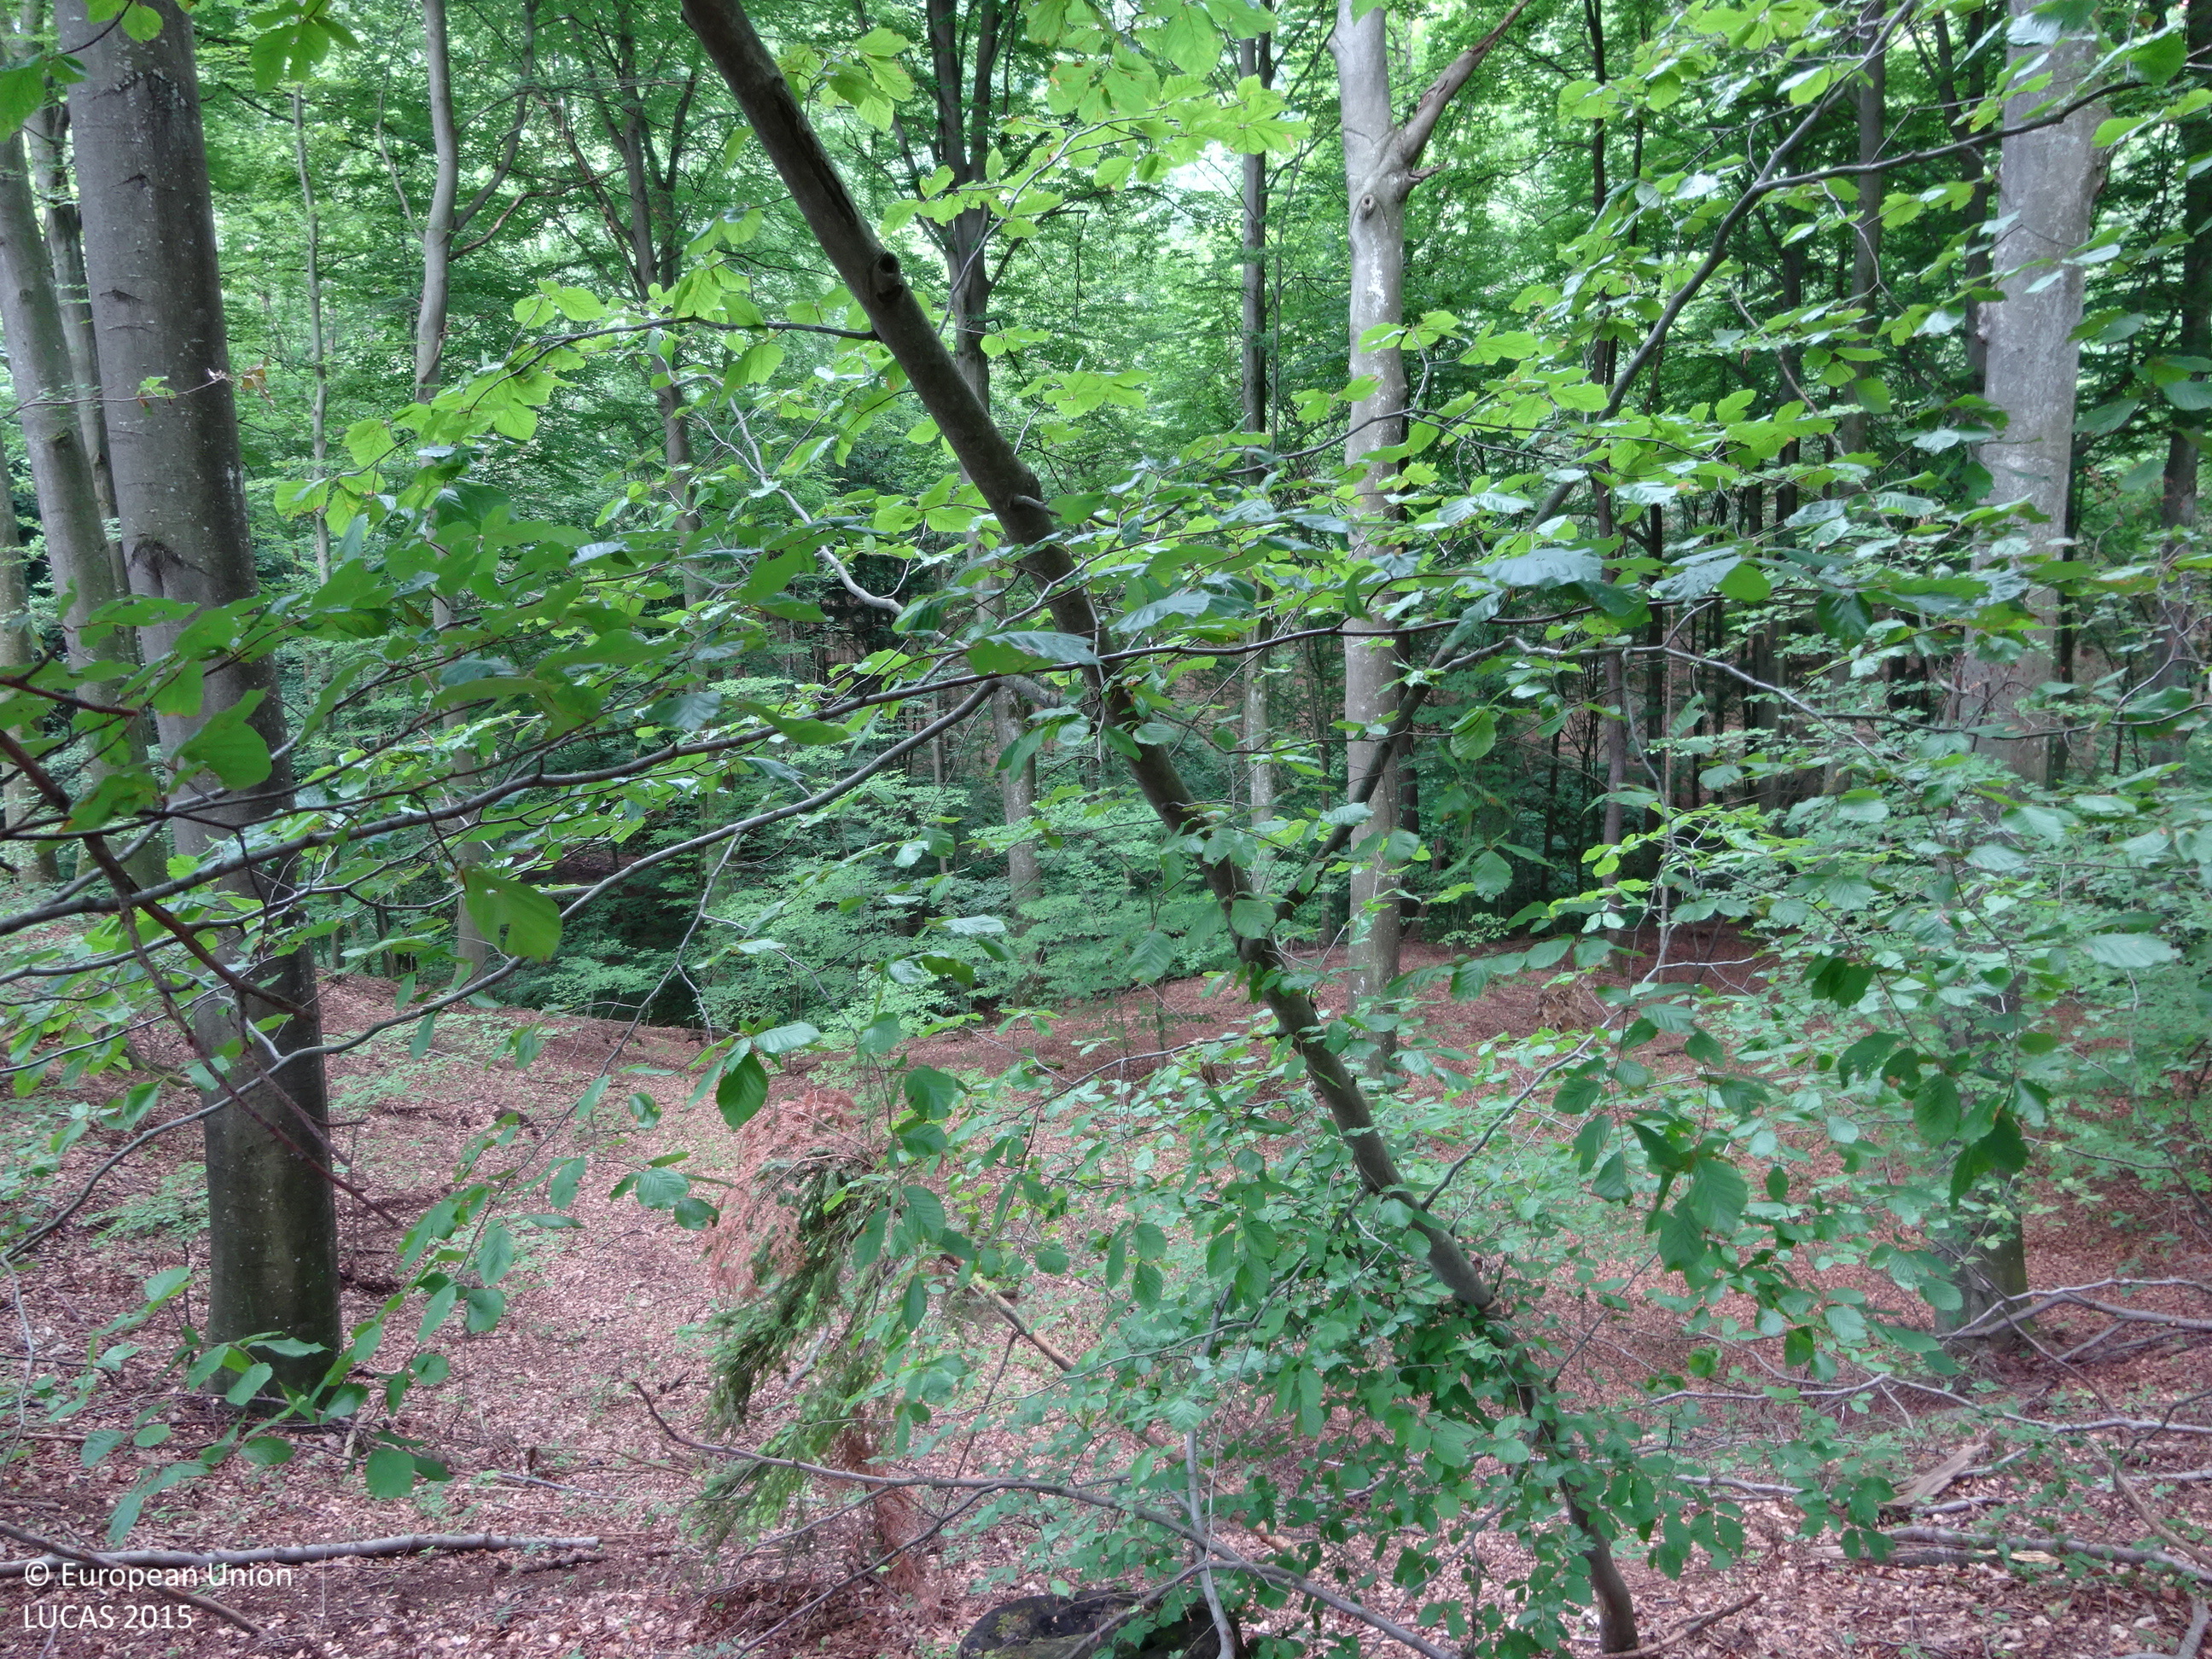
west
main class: Woodland
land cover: Broadleaved woodland
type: mountainous beech forest
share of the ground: > 75 %
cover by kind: broadleaved forest trees 90 %, unconsolidated bare surface 10 %
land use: Forestry
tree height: > 5 m
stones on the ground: < 10 %
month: June
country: AT
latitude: 46.6941
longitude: 15.5569
